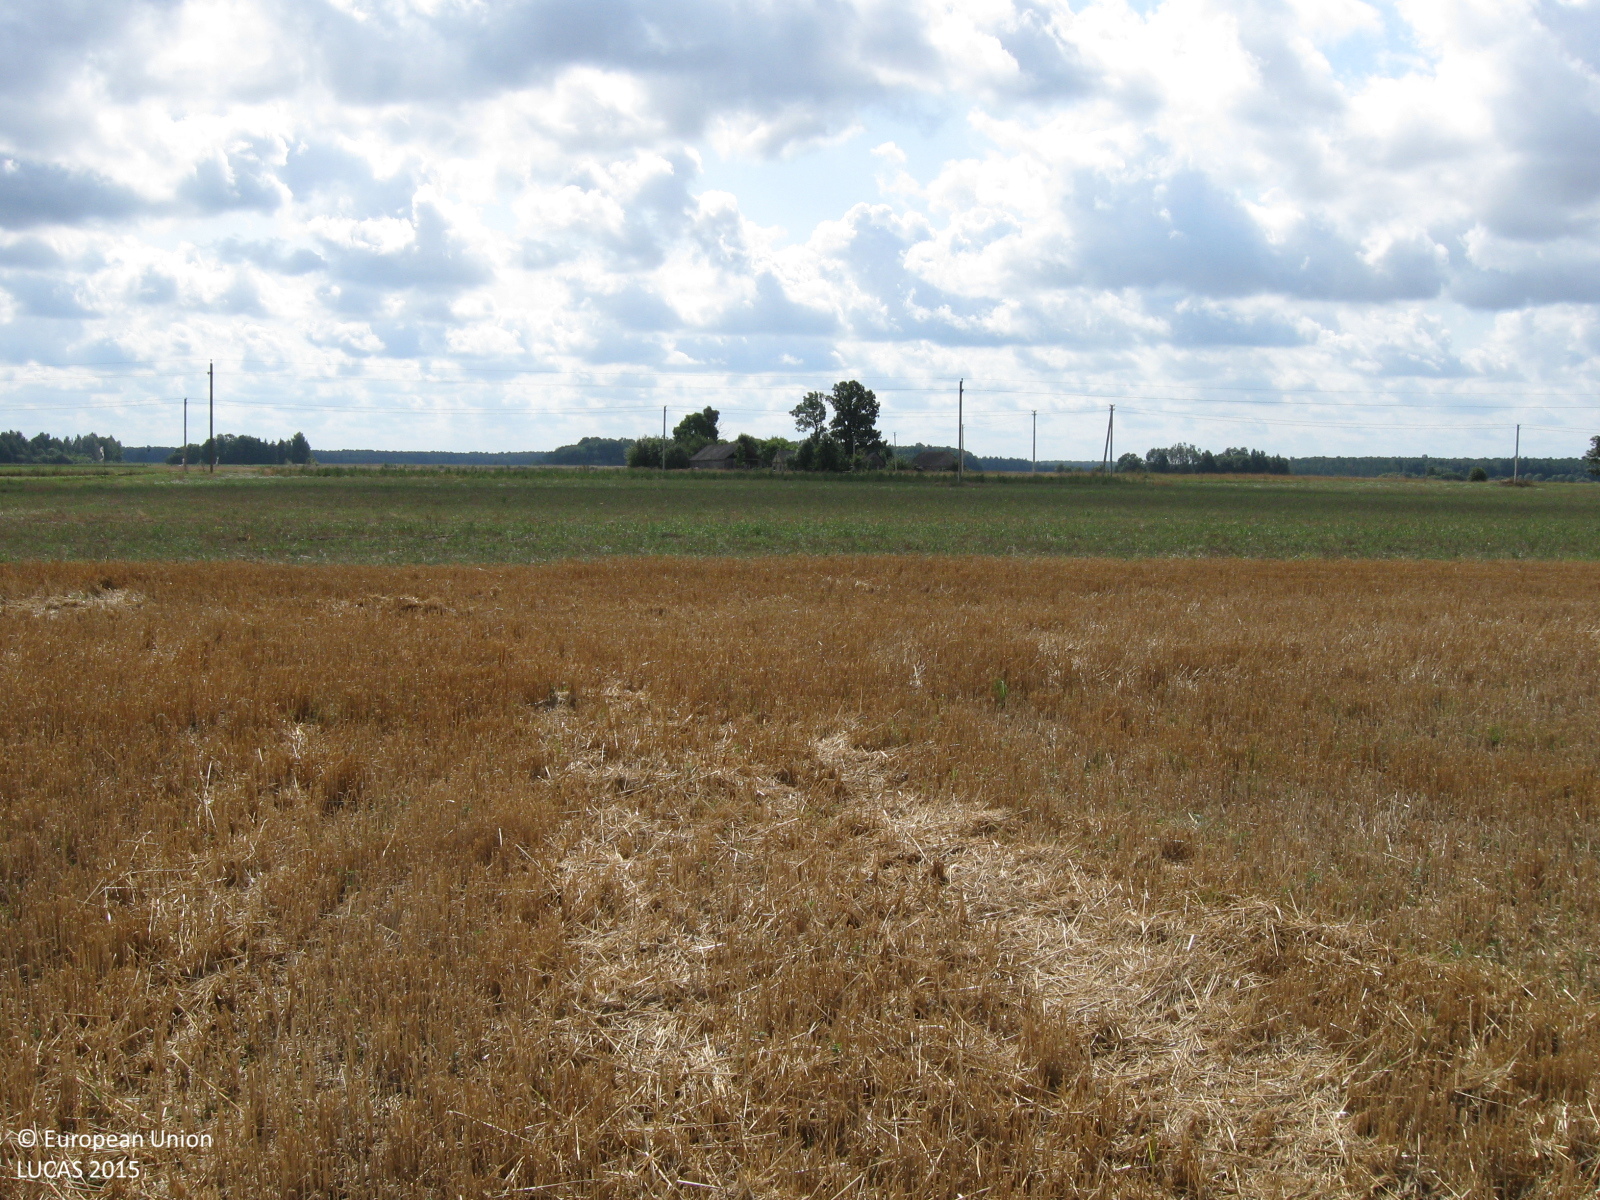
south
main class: Cropland
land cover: Common wheat
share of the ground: > 75 %
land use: Agriculture (excluding fallow land and kitchen gardens)
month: August
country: LT
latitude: 55.2521
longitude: 23.1464
